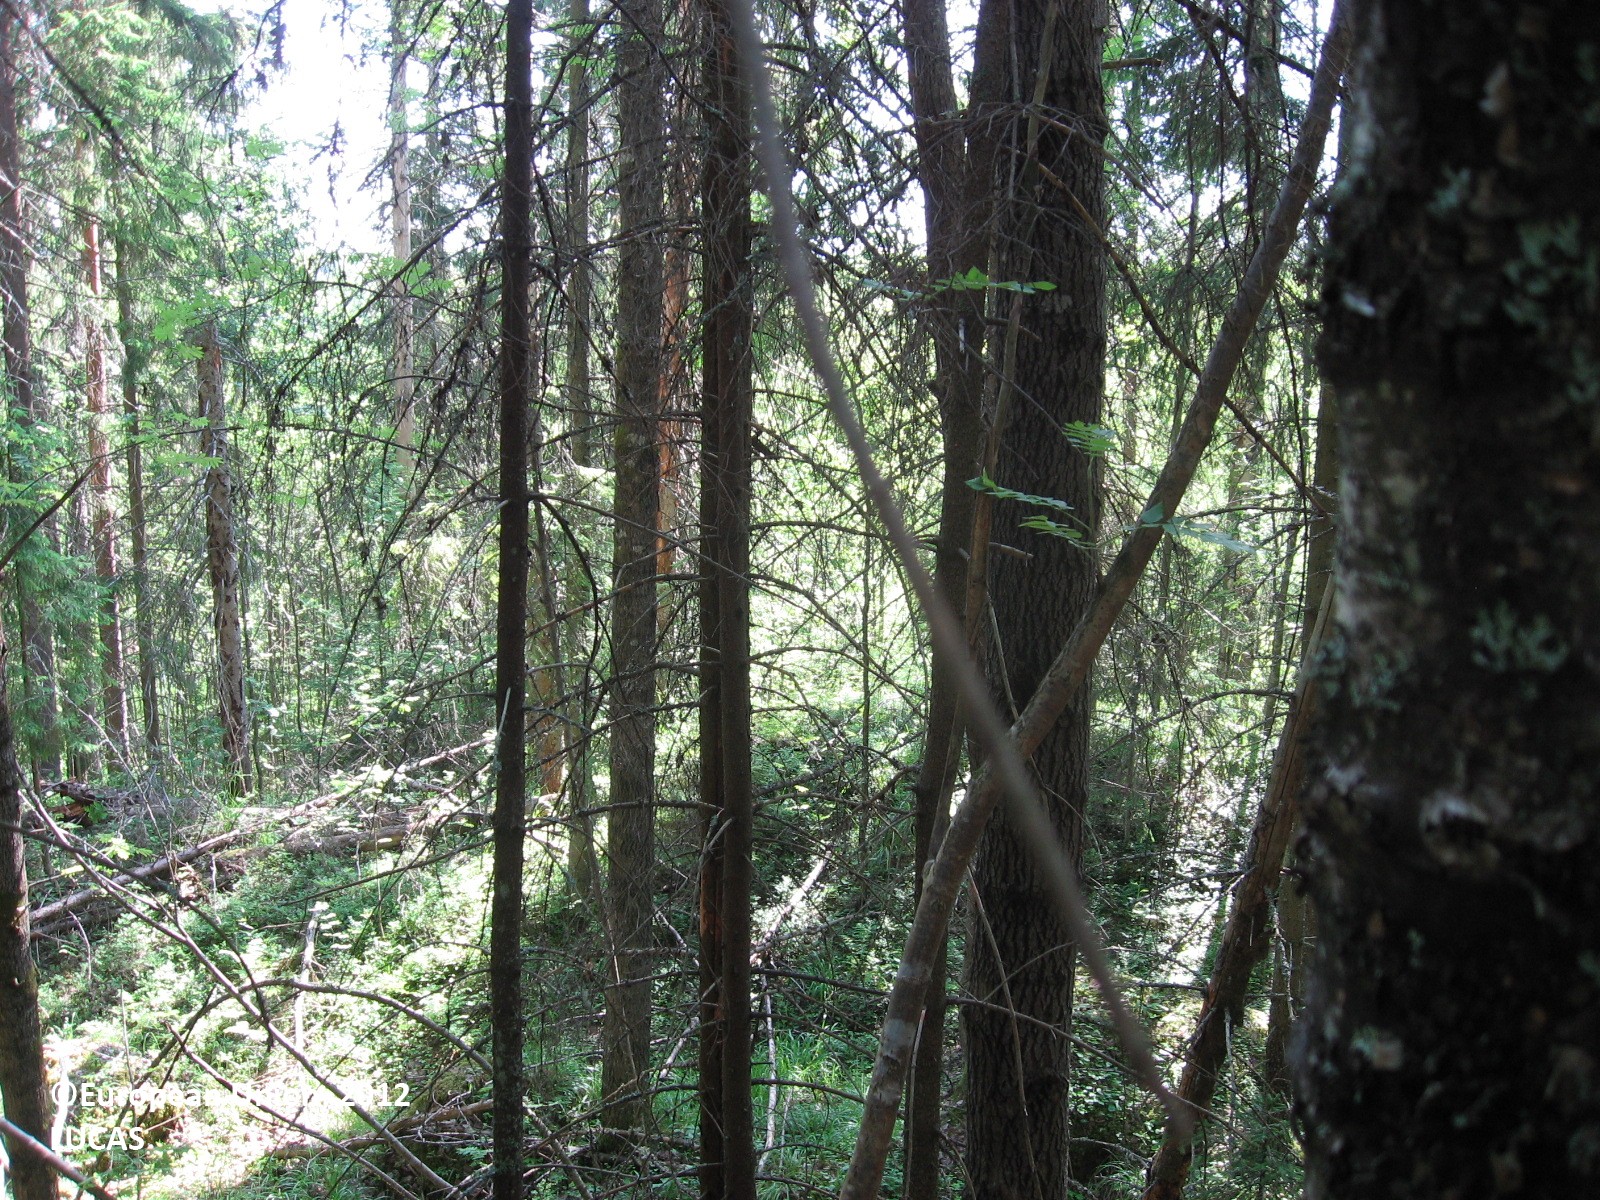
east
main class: Woodland
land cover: Spruce dominated mixed woodland
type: boreal forest
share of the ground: > 75 %
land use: Forestry
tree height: > 5 m
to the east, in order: Spruce dominated mixed woodland; Broadleaved woodland; Ditches and canals; Grass margins; Oats; Grass margins; Ditches and canals; Spruce dominated mixed woodland; Ditches and canals; Spruce dominated mixed woodland; Ditches and canals; Spruce dominated mixed woodland
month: July
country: FI
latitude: 60.8404
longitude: 26.5099
